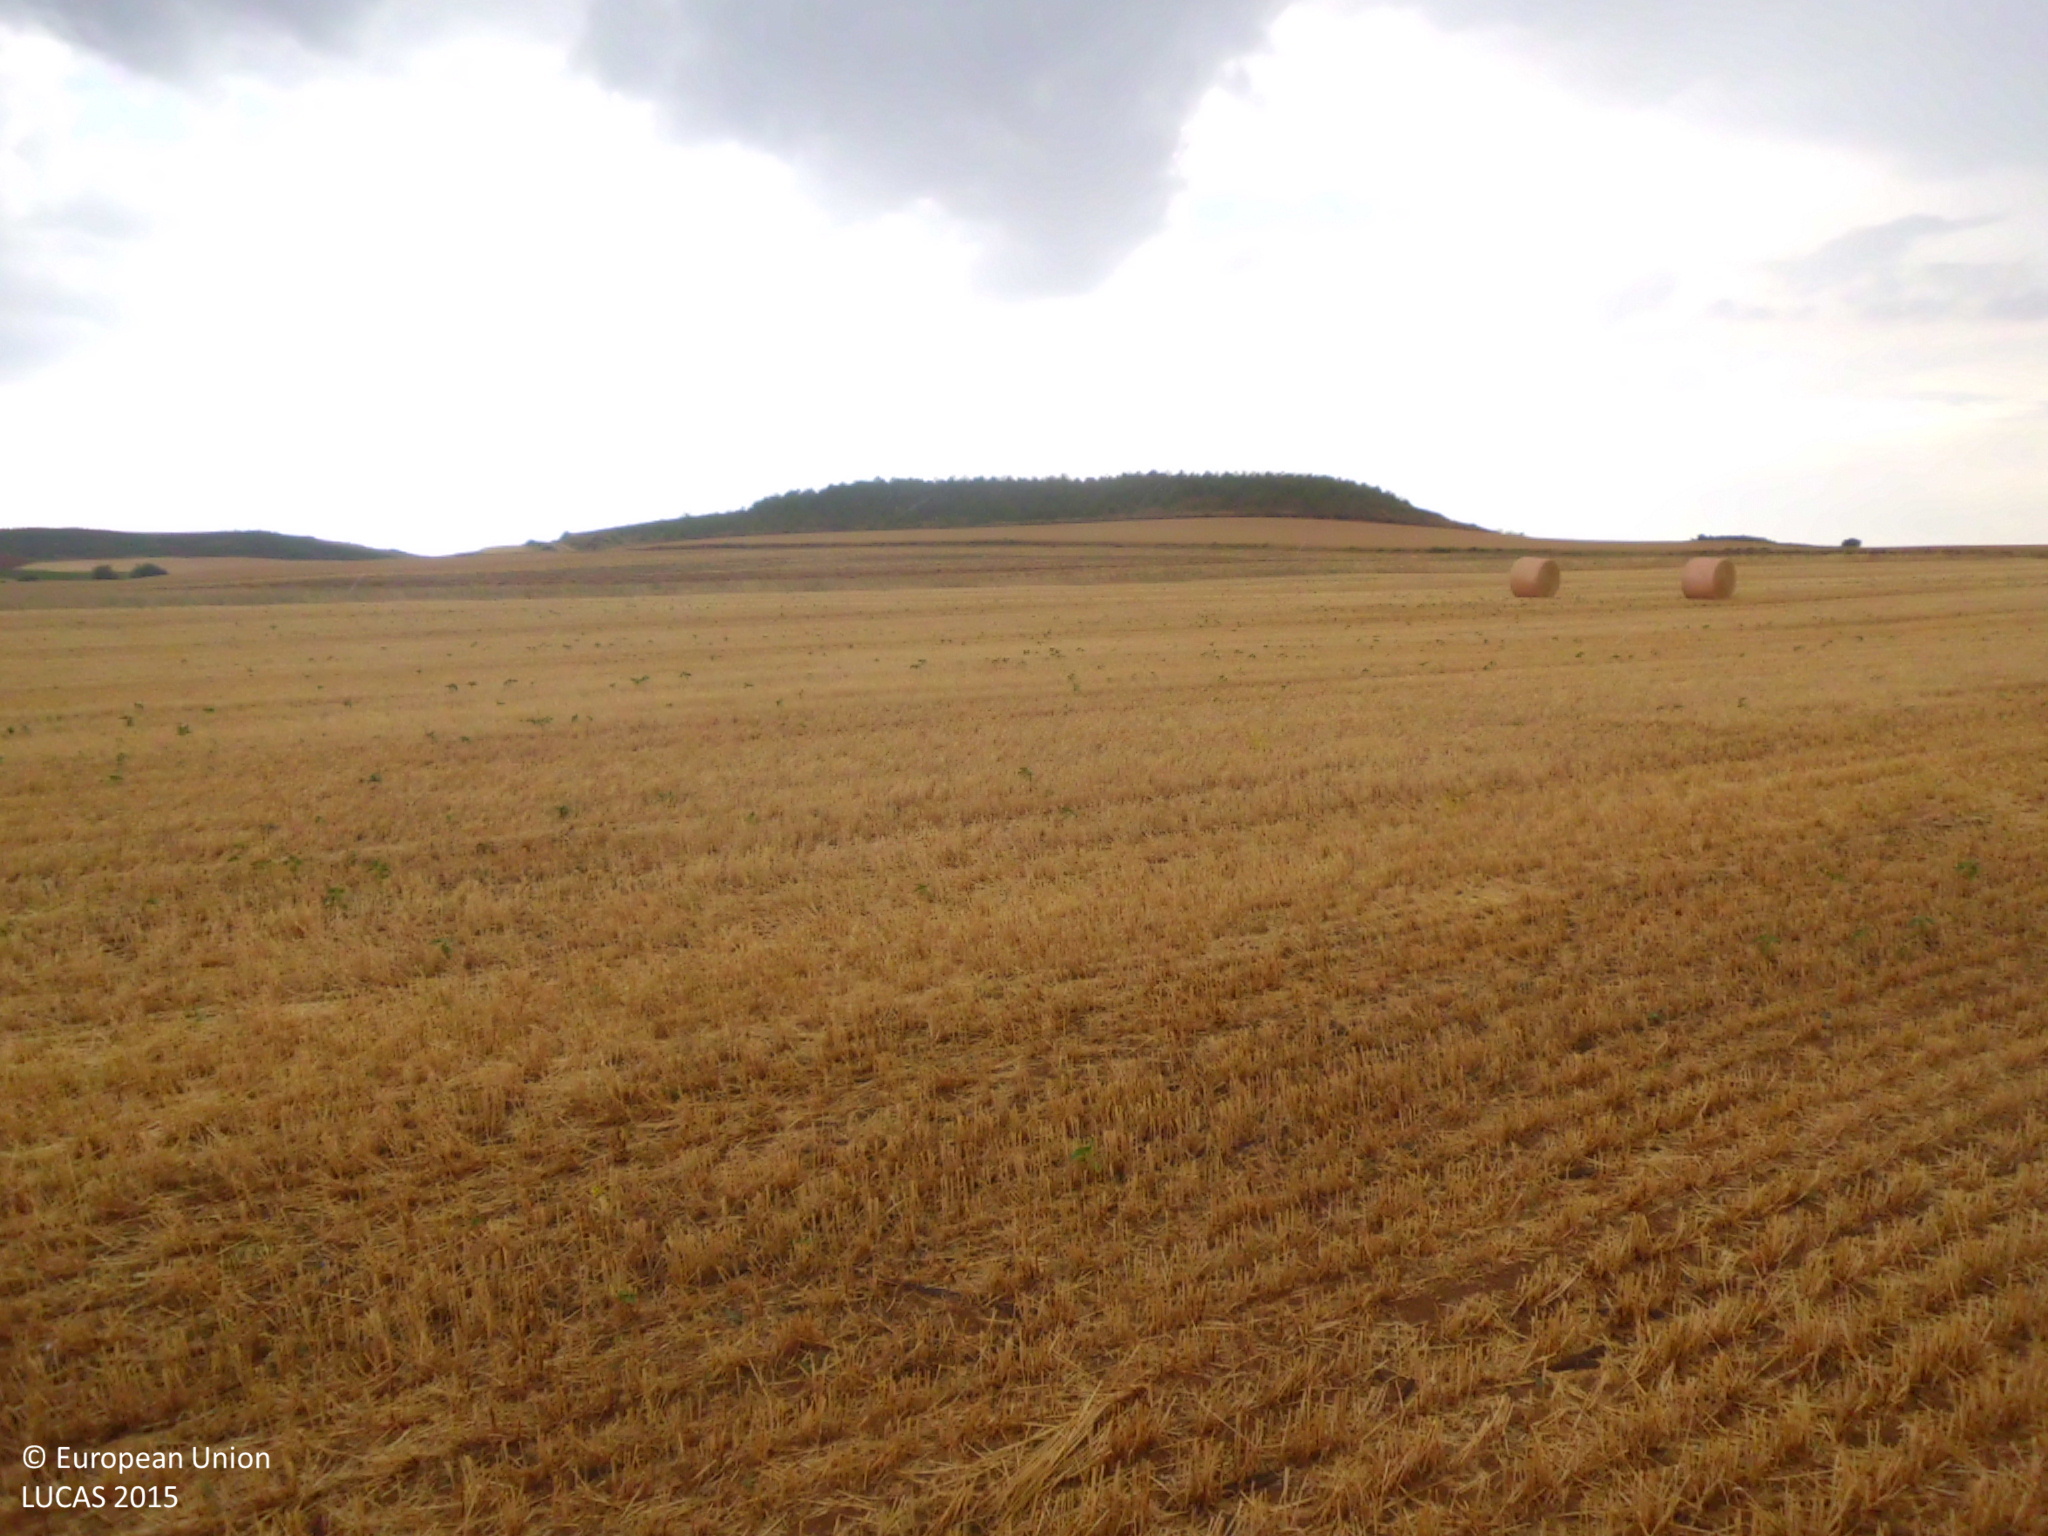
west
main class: Cropland
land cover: Common wheat
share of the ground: < 10 %
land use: Agriculture (excluding fallow land and kitchen gardens)
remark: Harvested field
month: July
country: ES
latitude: 42.6470
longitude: -4.3822
